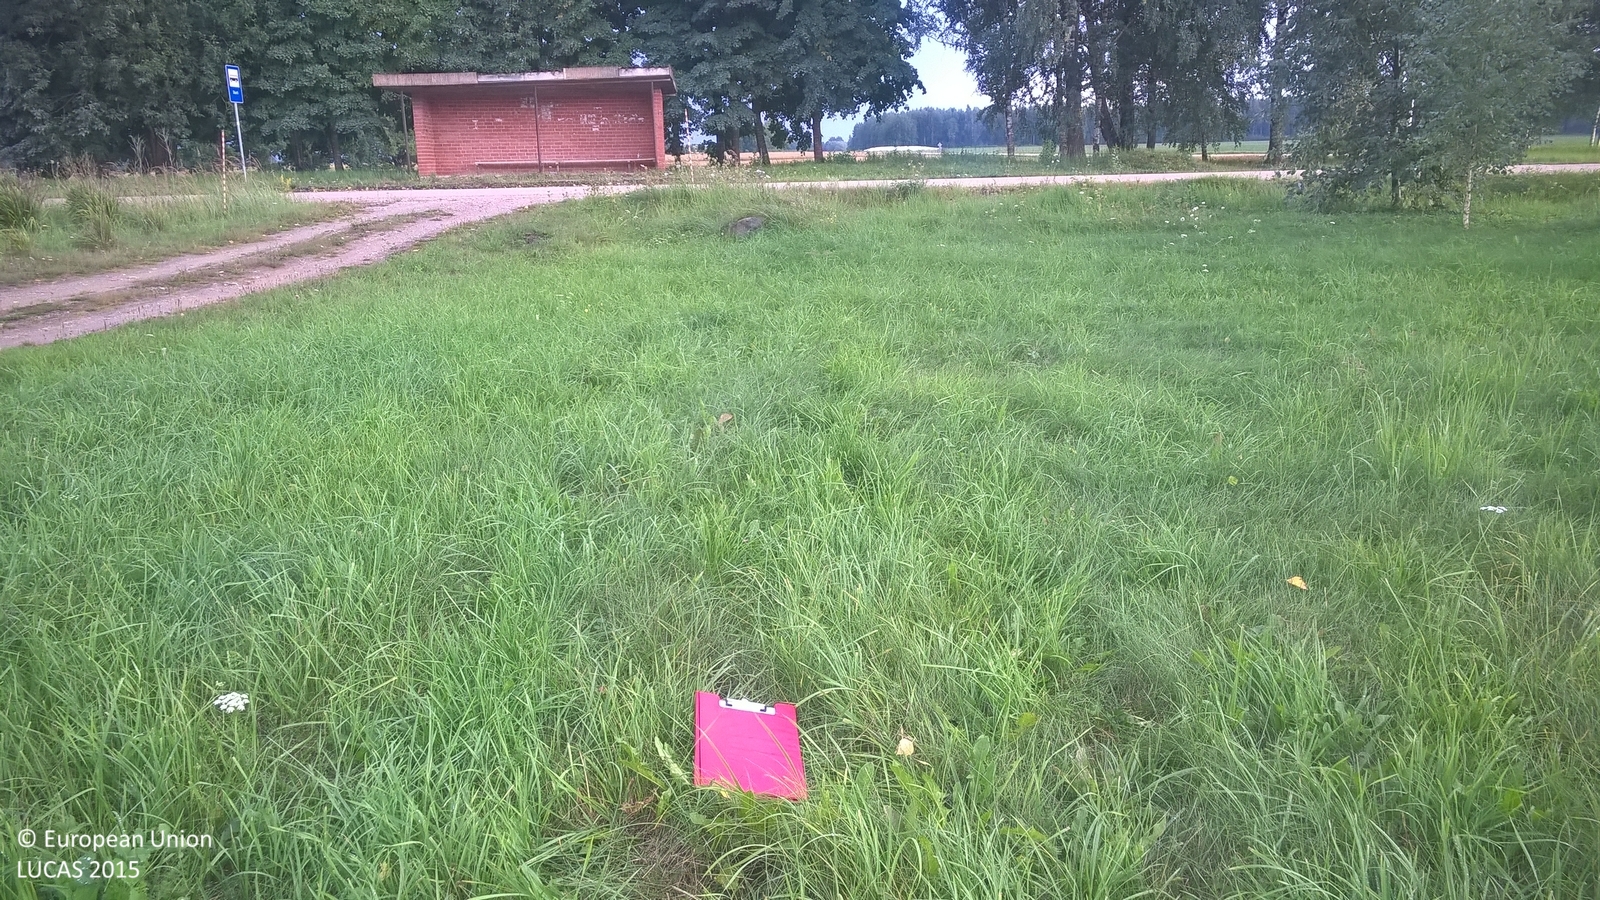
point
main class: Grassland
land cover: Grassland without tree/shrub cover
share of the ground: > 75 %
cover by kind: herbaceous plants 100 %
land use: Residential
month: September
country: LV
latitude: 57.4025
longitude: 25.5105
